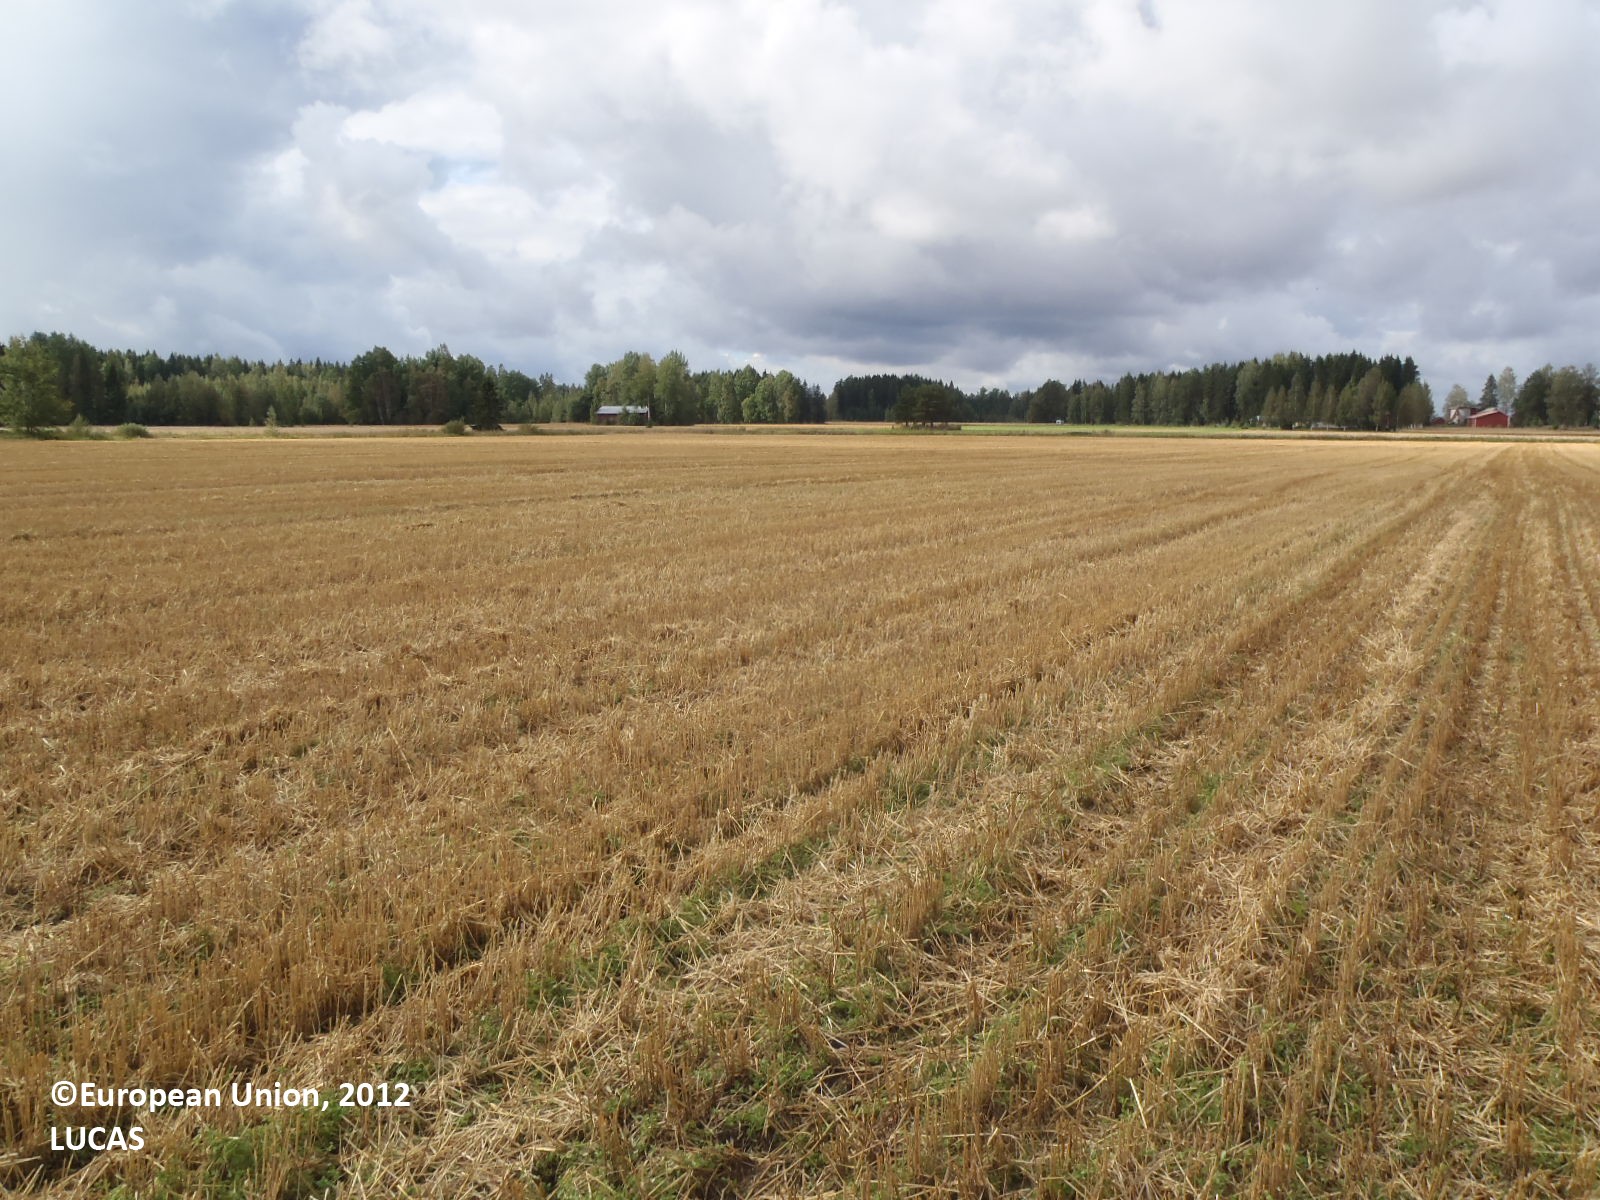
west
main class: Cropland
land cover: Barley
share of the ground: 50 - 75 %
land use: Agriculture (excluding fallow land and kitchen gardens)
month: September
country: FI
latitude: 61.0603
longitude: 22.7608
